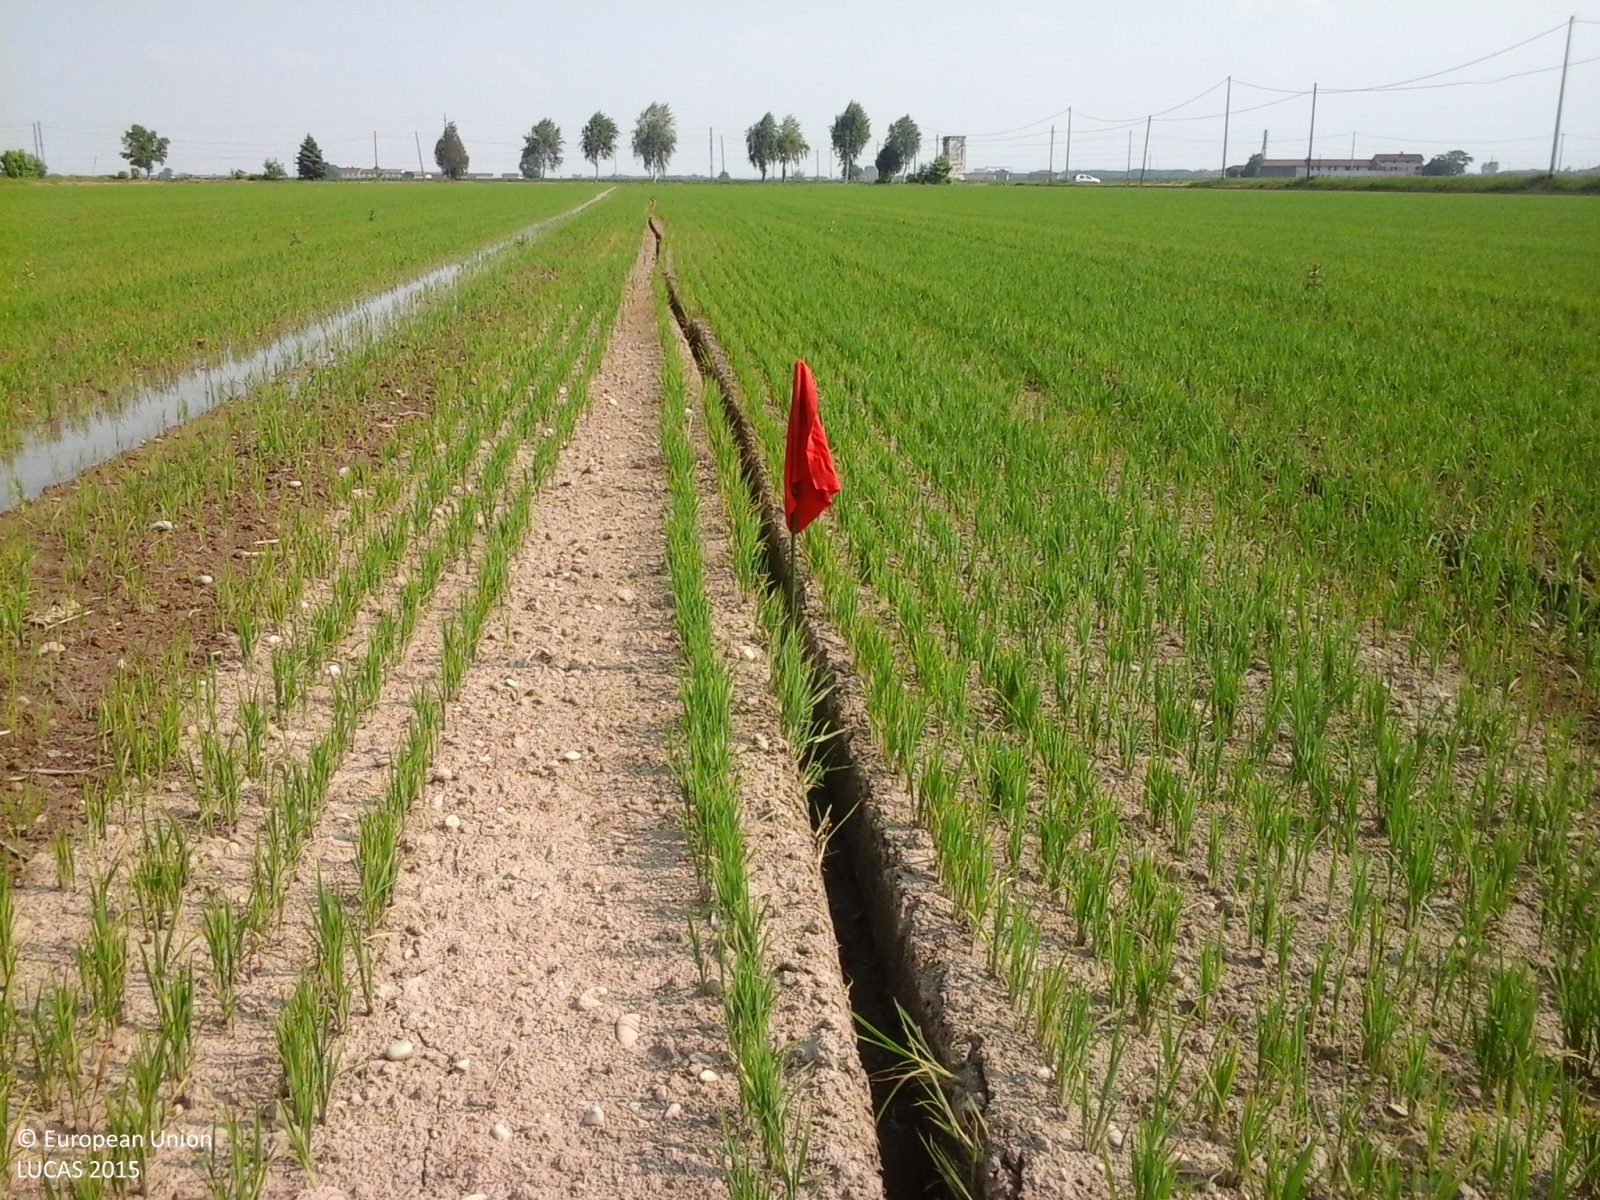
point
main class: Cropland
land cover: Rice
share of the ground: 25 - 50 %
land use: Agriculture (excluding fallow land and kitchen gardens)
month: May
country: IT
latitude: 45.3809
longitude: 8.2023
